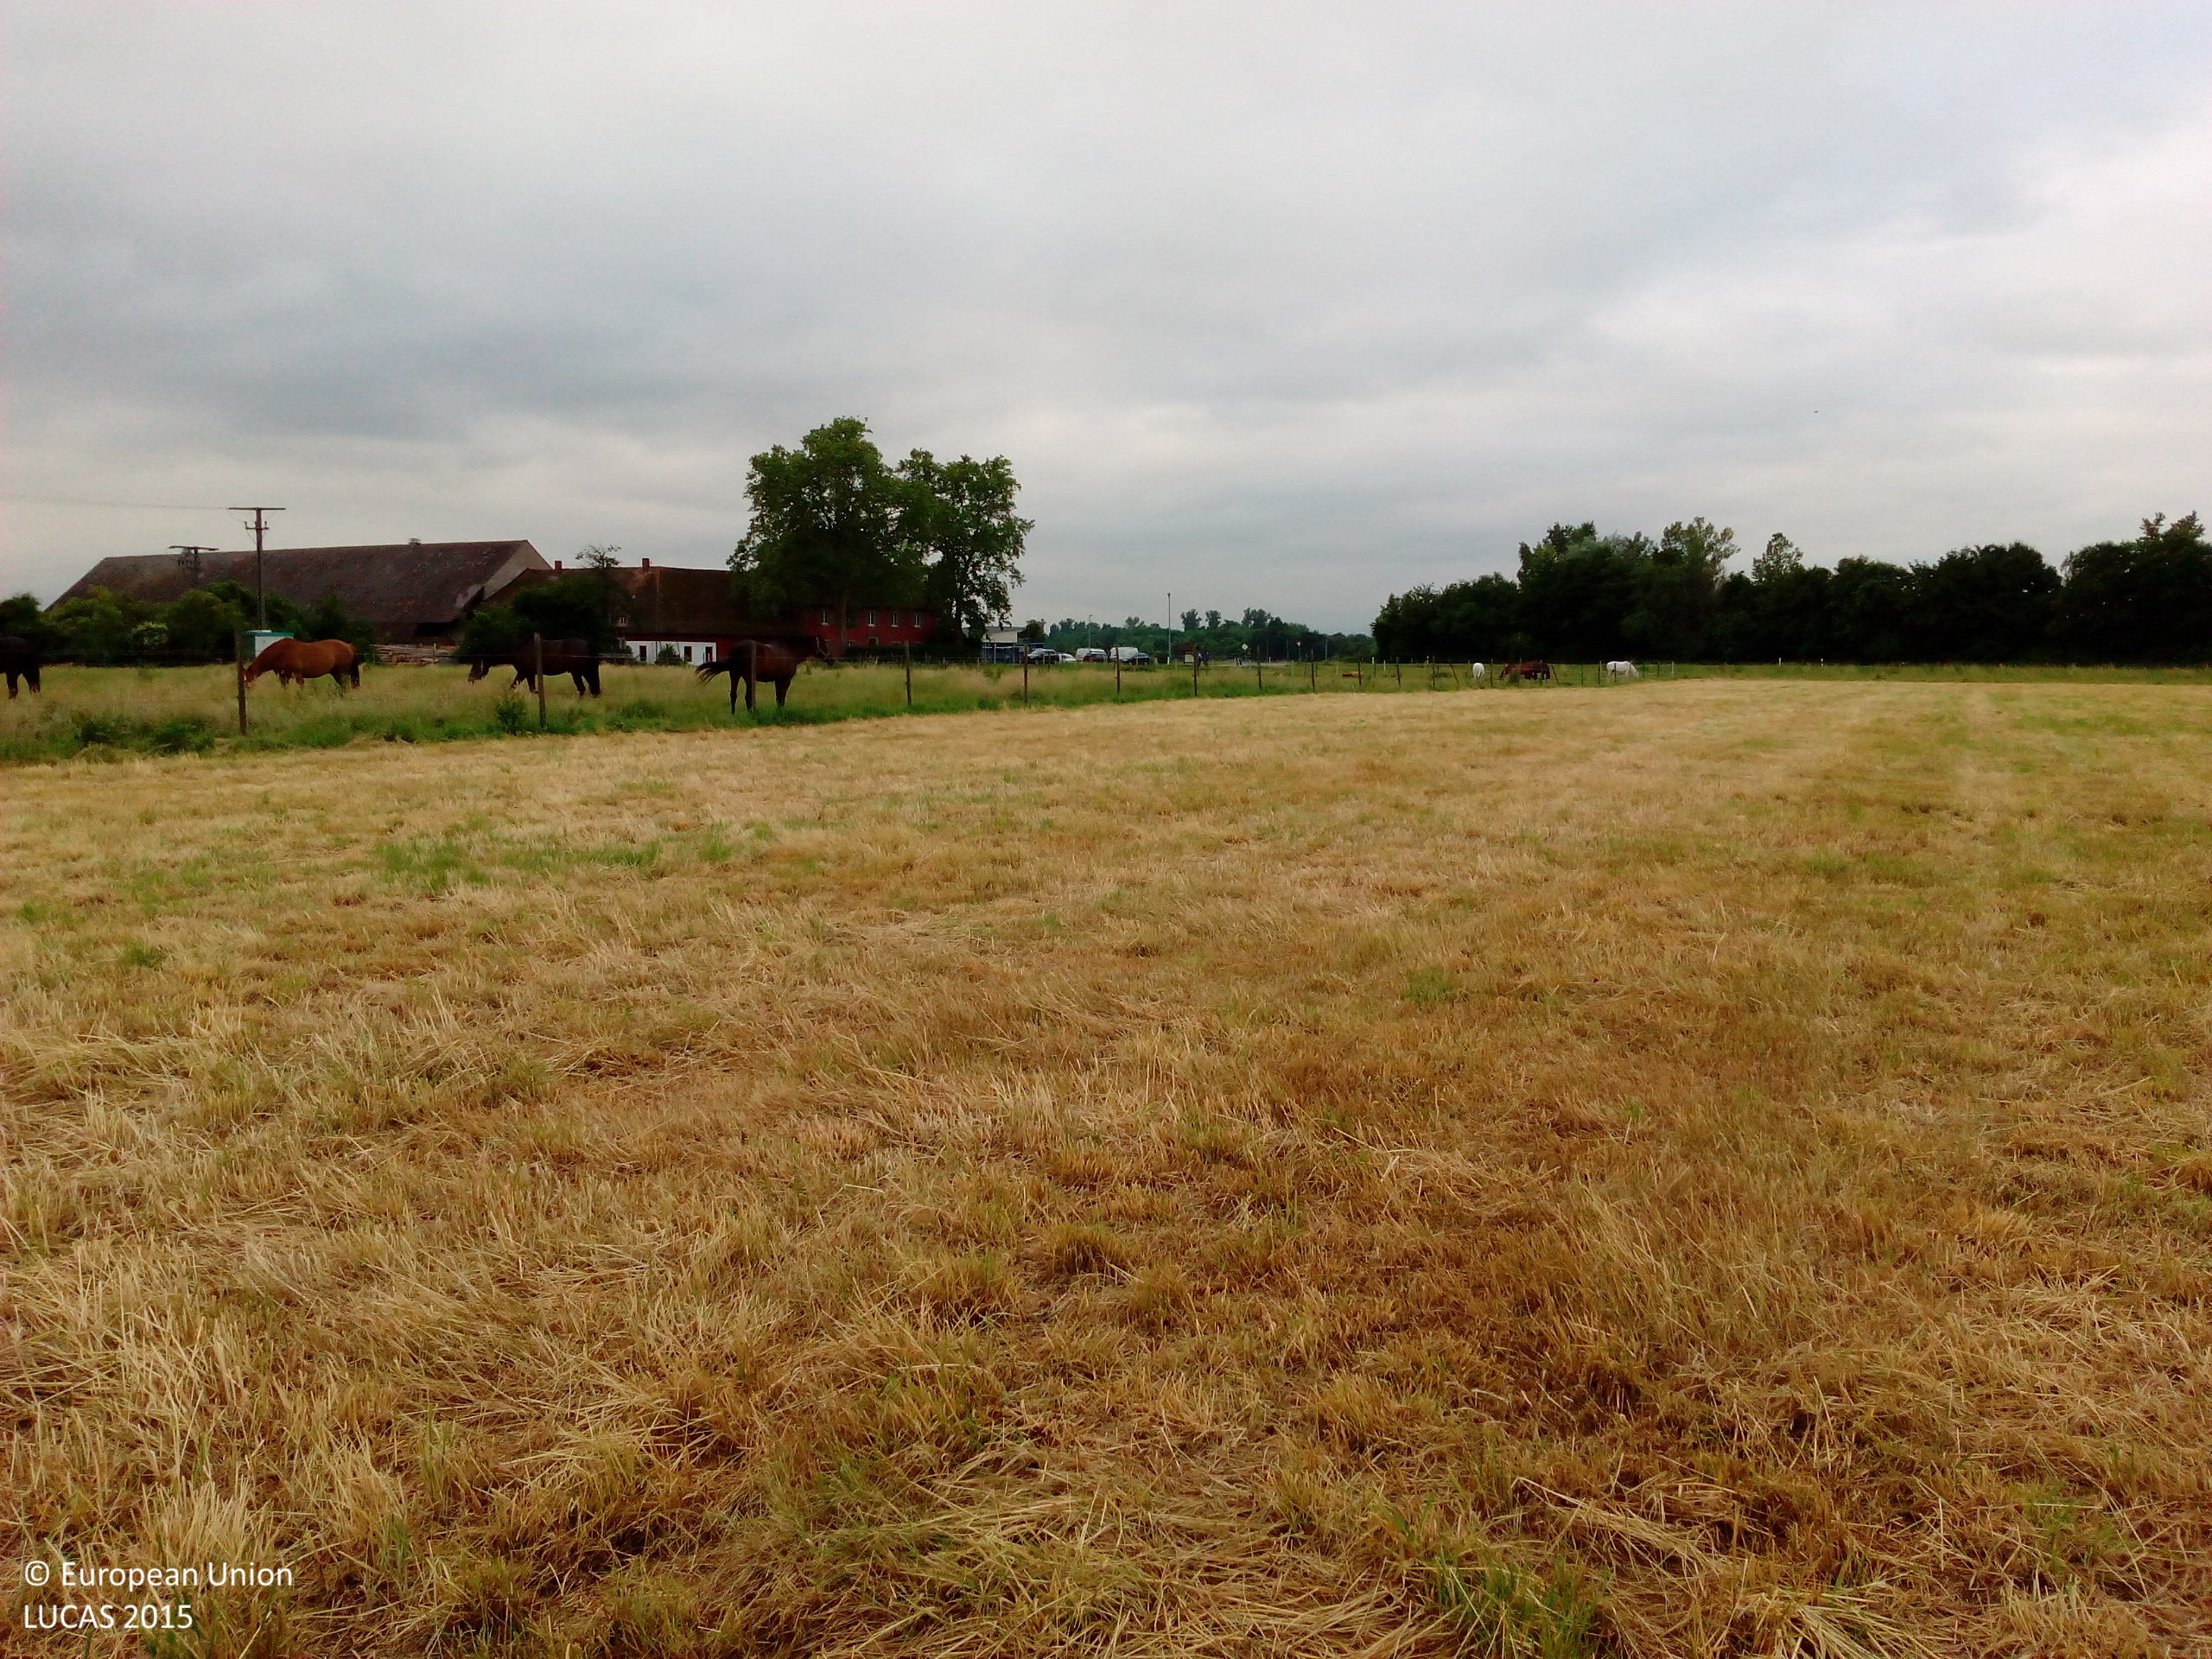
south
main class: Grassland
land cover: Grassland without tree/shrub cover
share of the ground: > 75 %
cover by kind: herbaceous plants 100 %
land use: Agriculture (excluding fallow land and kitchen gardens)
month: June
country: DE
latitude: 48.0000
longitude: 7.6289
